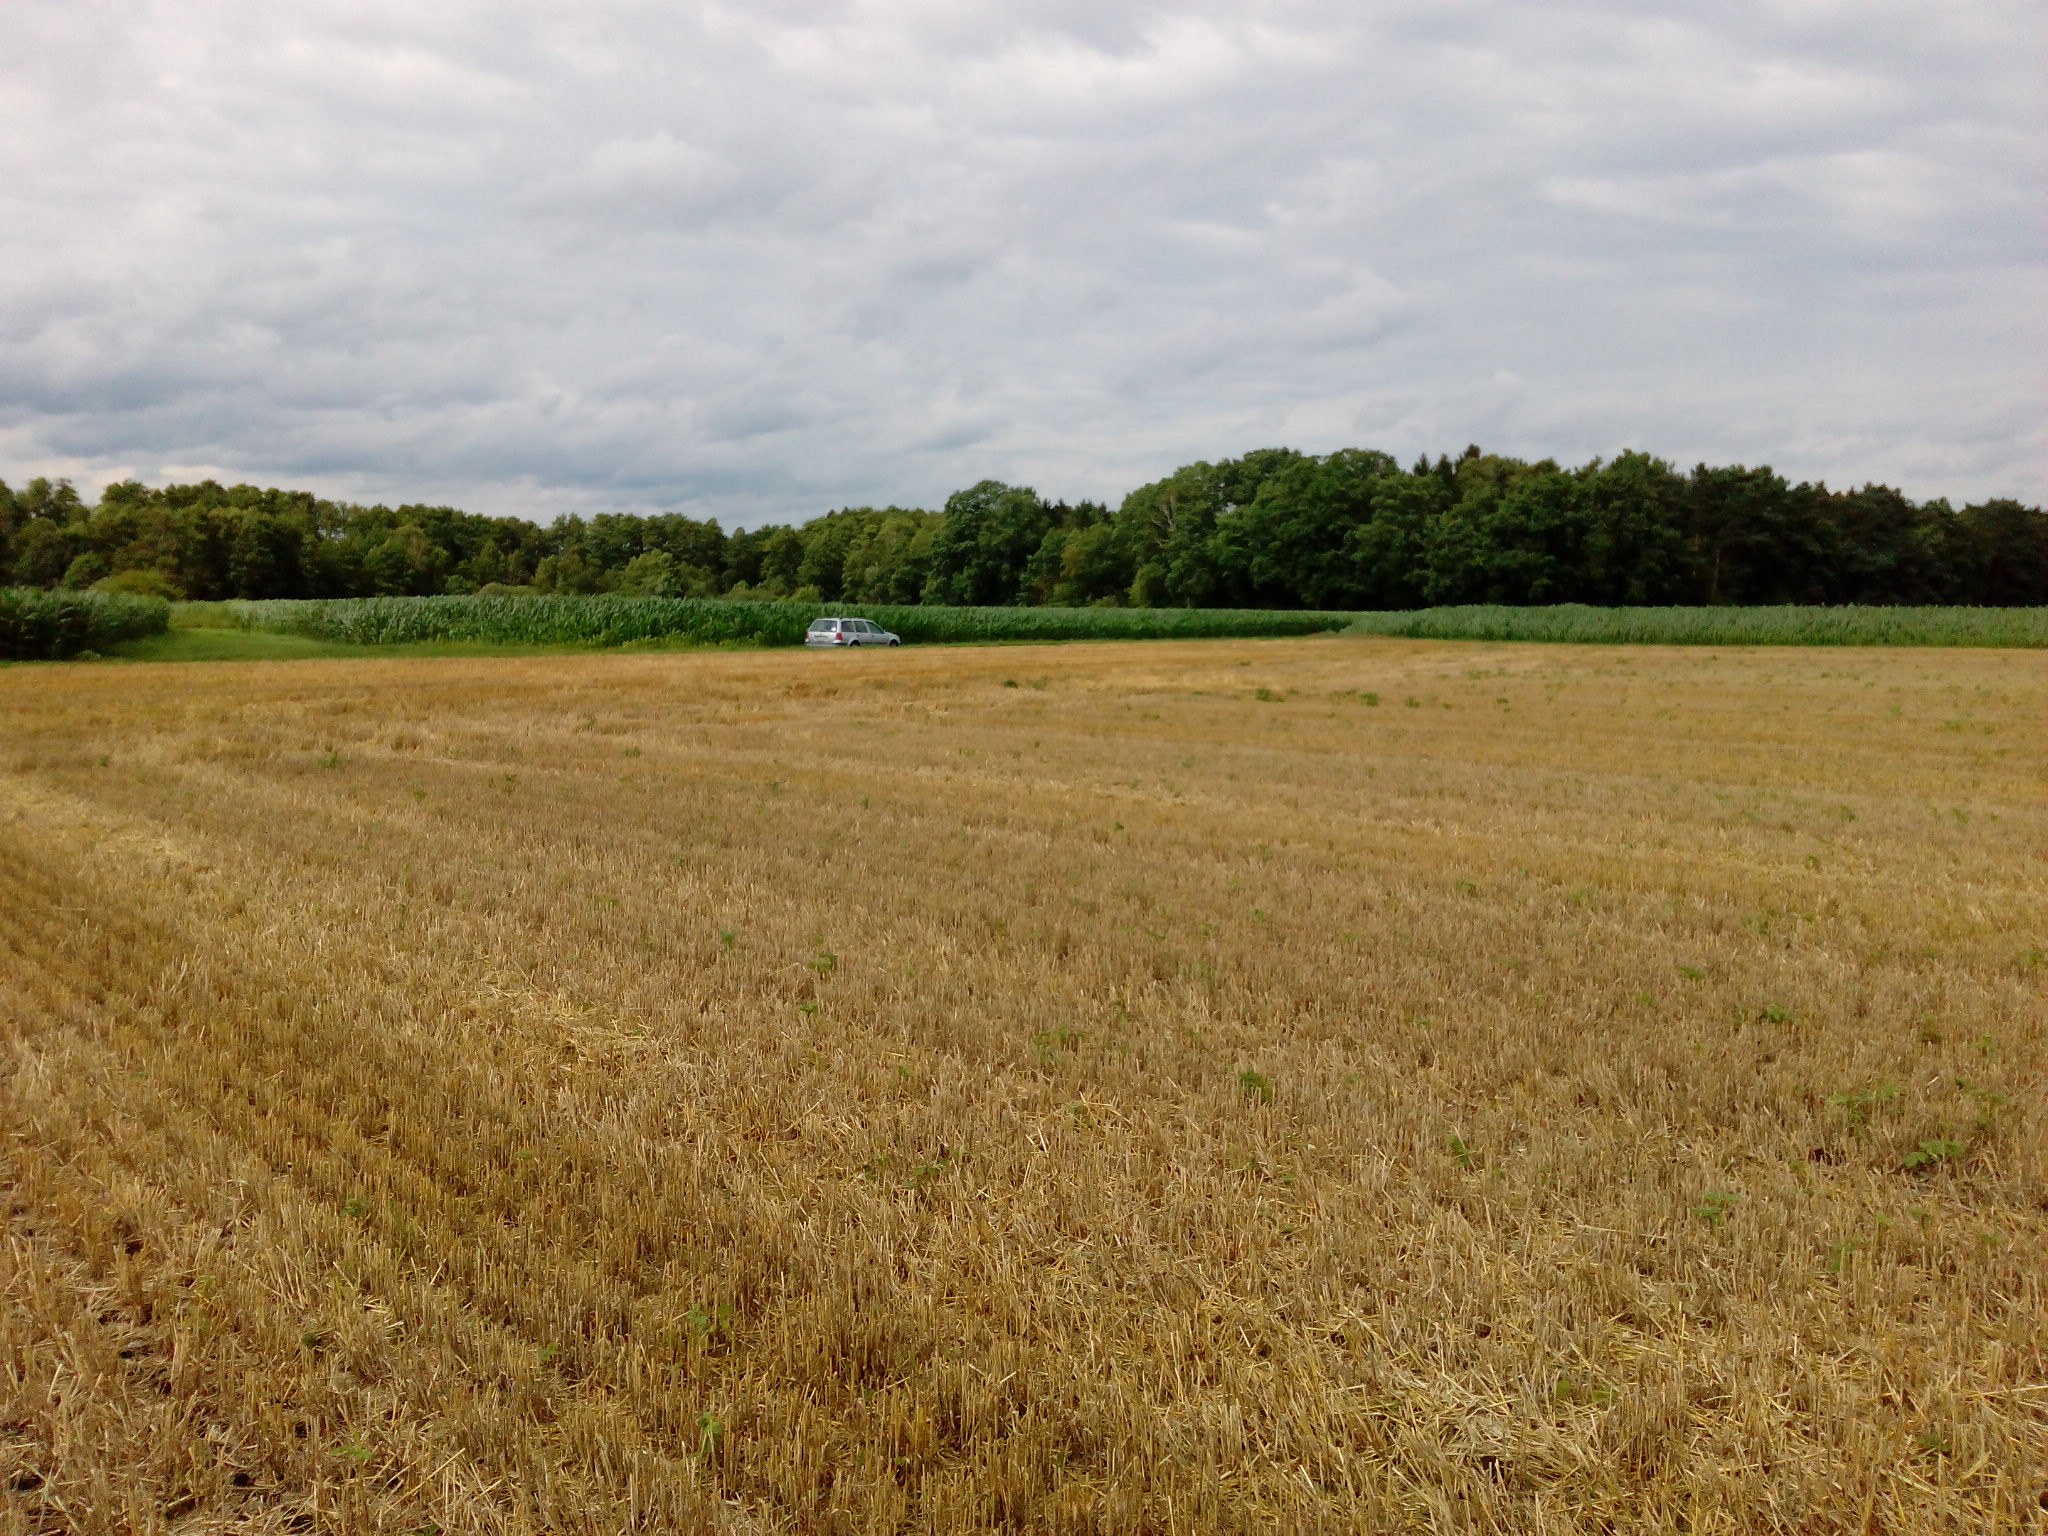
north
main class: Cropland
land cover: Rye
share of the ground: > 75 %
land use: Agriculture (excluding fallow land and kitchen gardens)
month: July
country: DE
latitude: 52.9705
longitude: 9.8660
